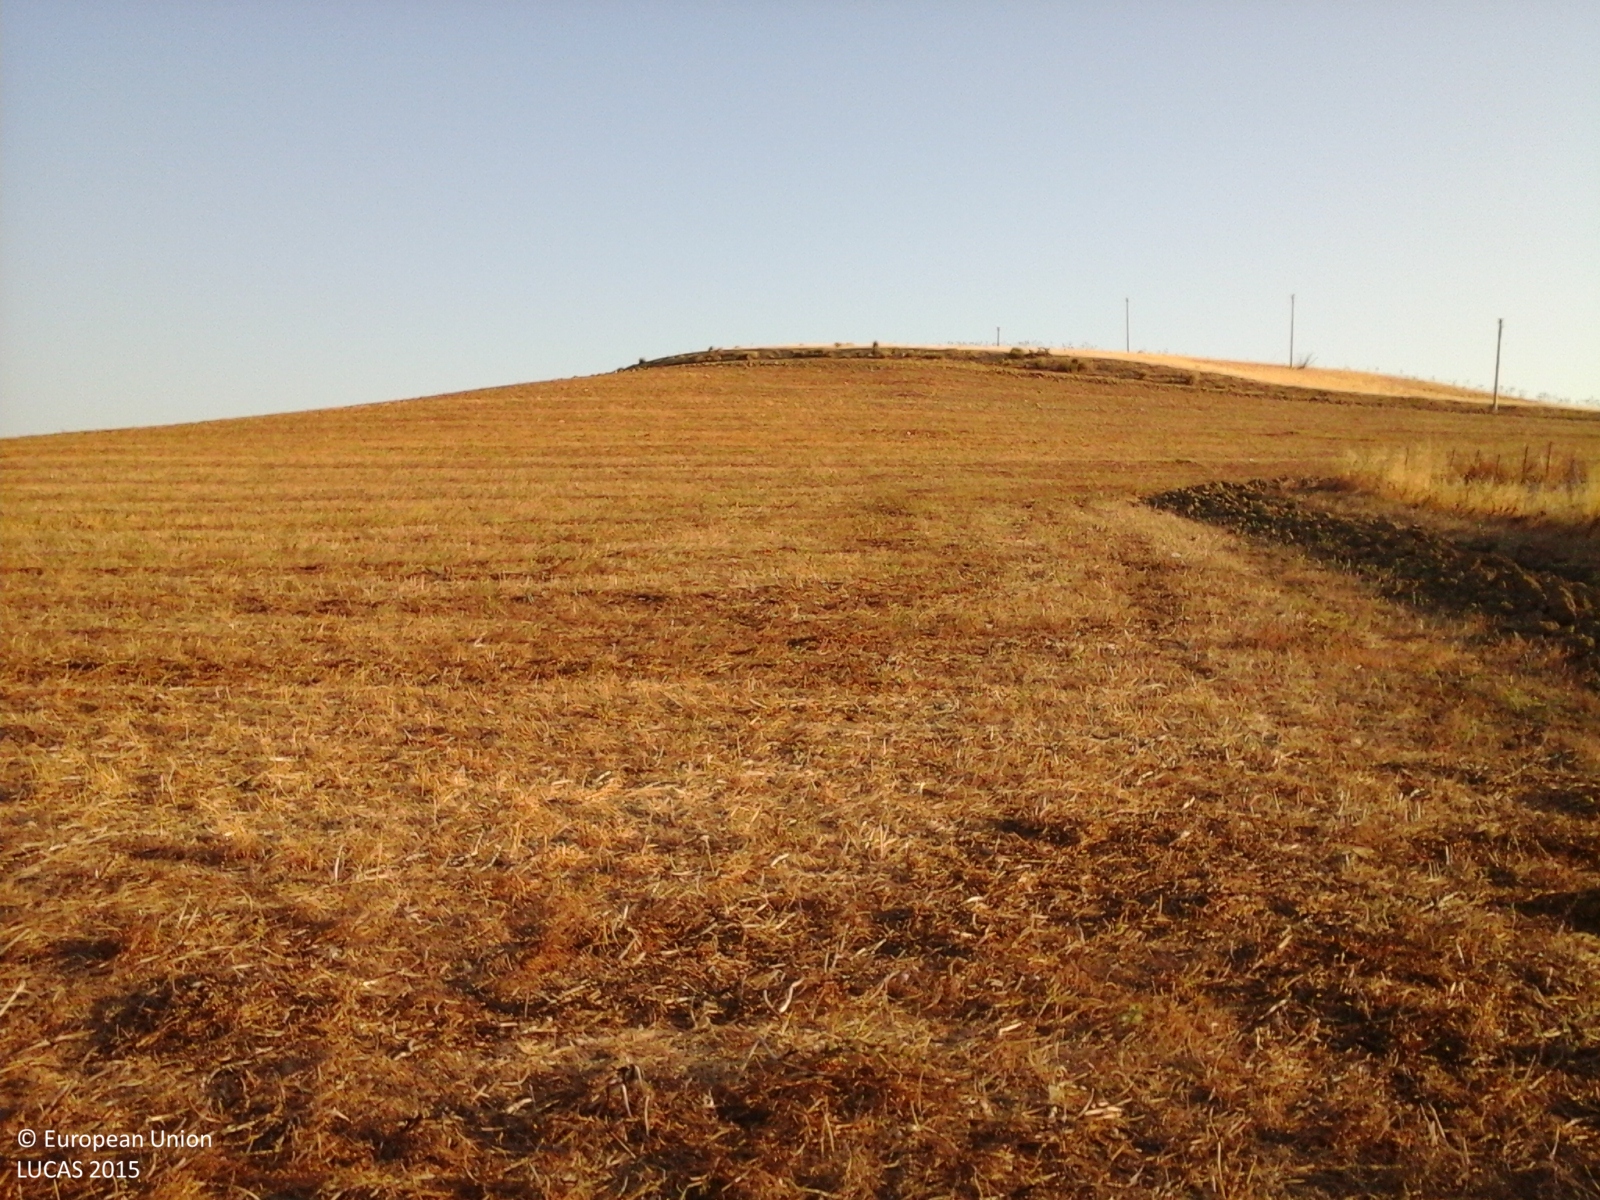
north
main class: Cropland
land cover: Other leguminous and mixtures for fodder
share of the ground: > 75 %
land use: Agriculture (excluding fallow land and kitchen gardens)
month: July
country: IT
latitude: 37.1138
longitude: 14.0978
